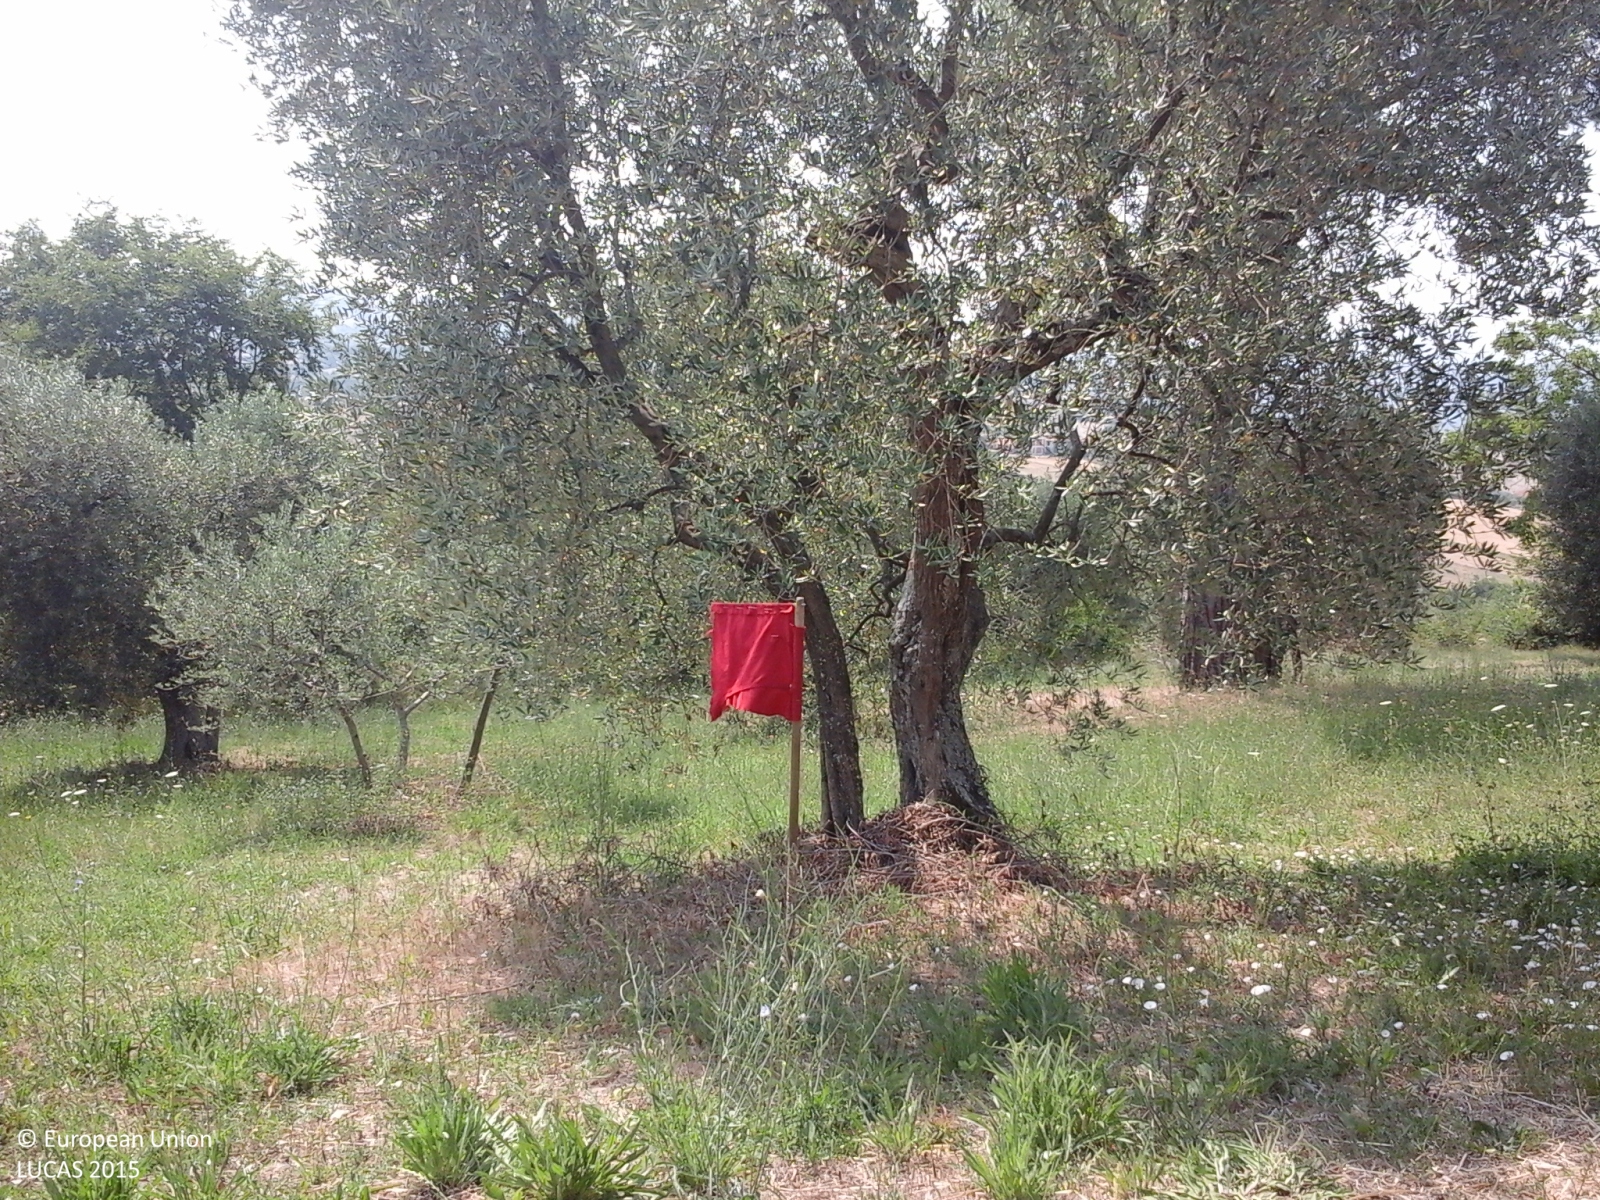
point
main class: Cropland
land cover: Olive groves
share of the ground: > 75 %
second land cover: Spontaneously vegetated surfaces
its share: > 75 %
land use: Agriculture (excluding fallow land and kitchen gardens)
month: July
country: IT
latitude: 40.9864
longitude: 15.1035
